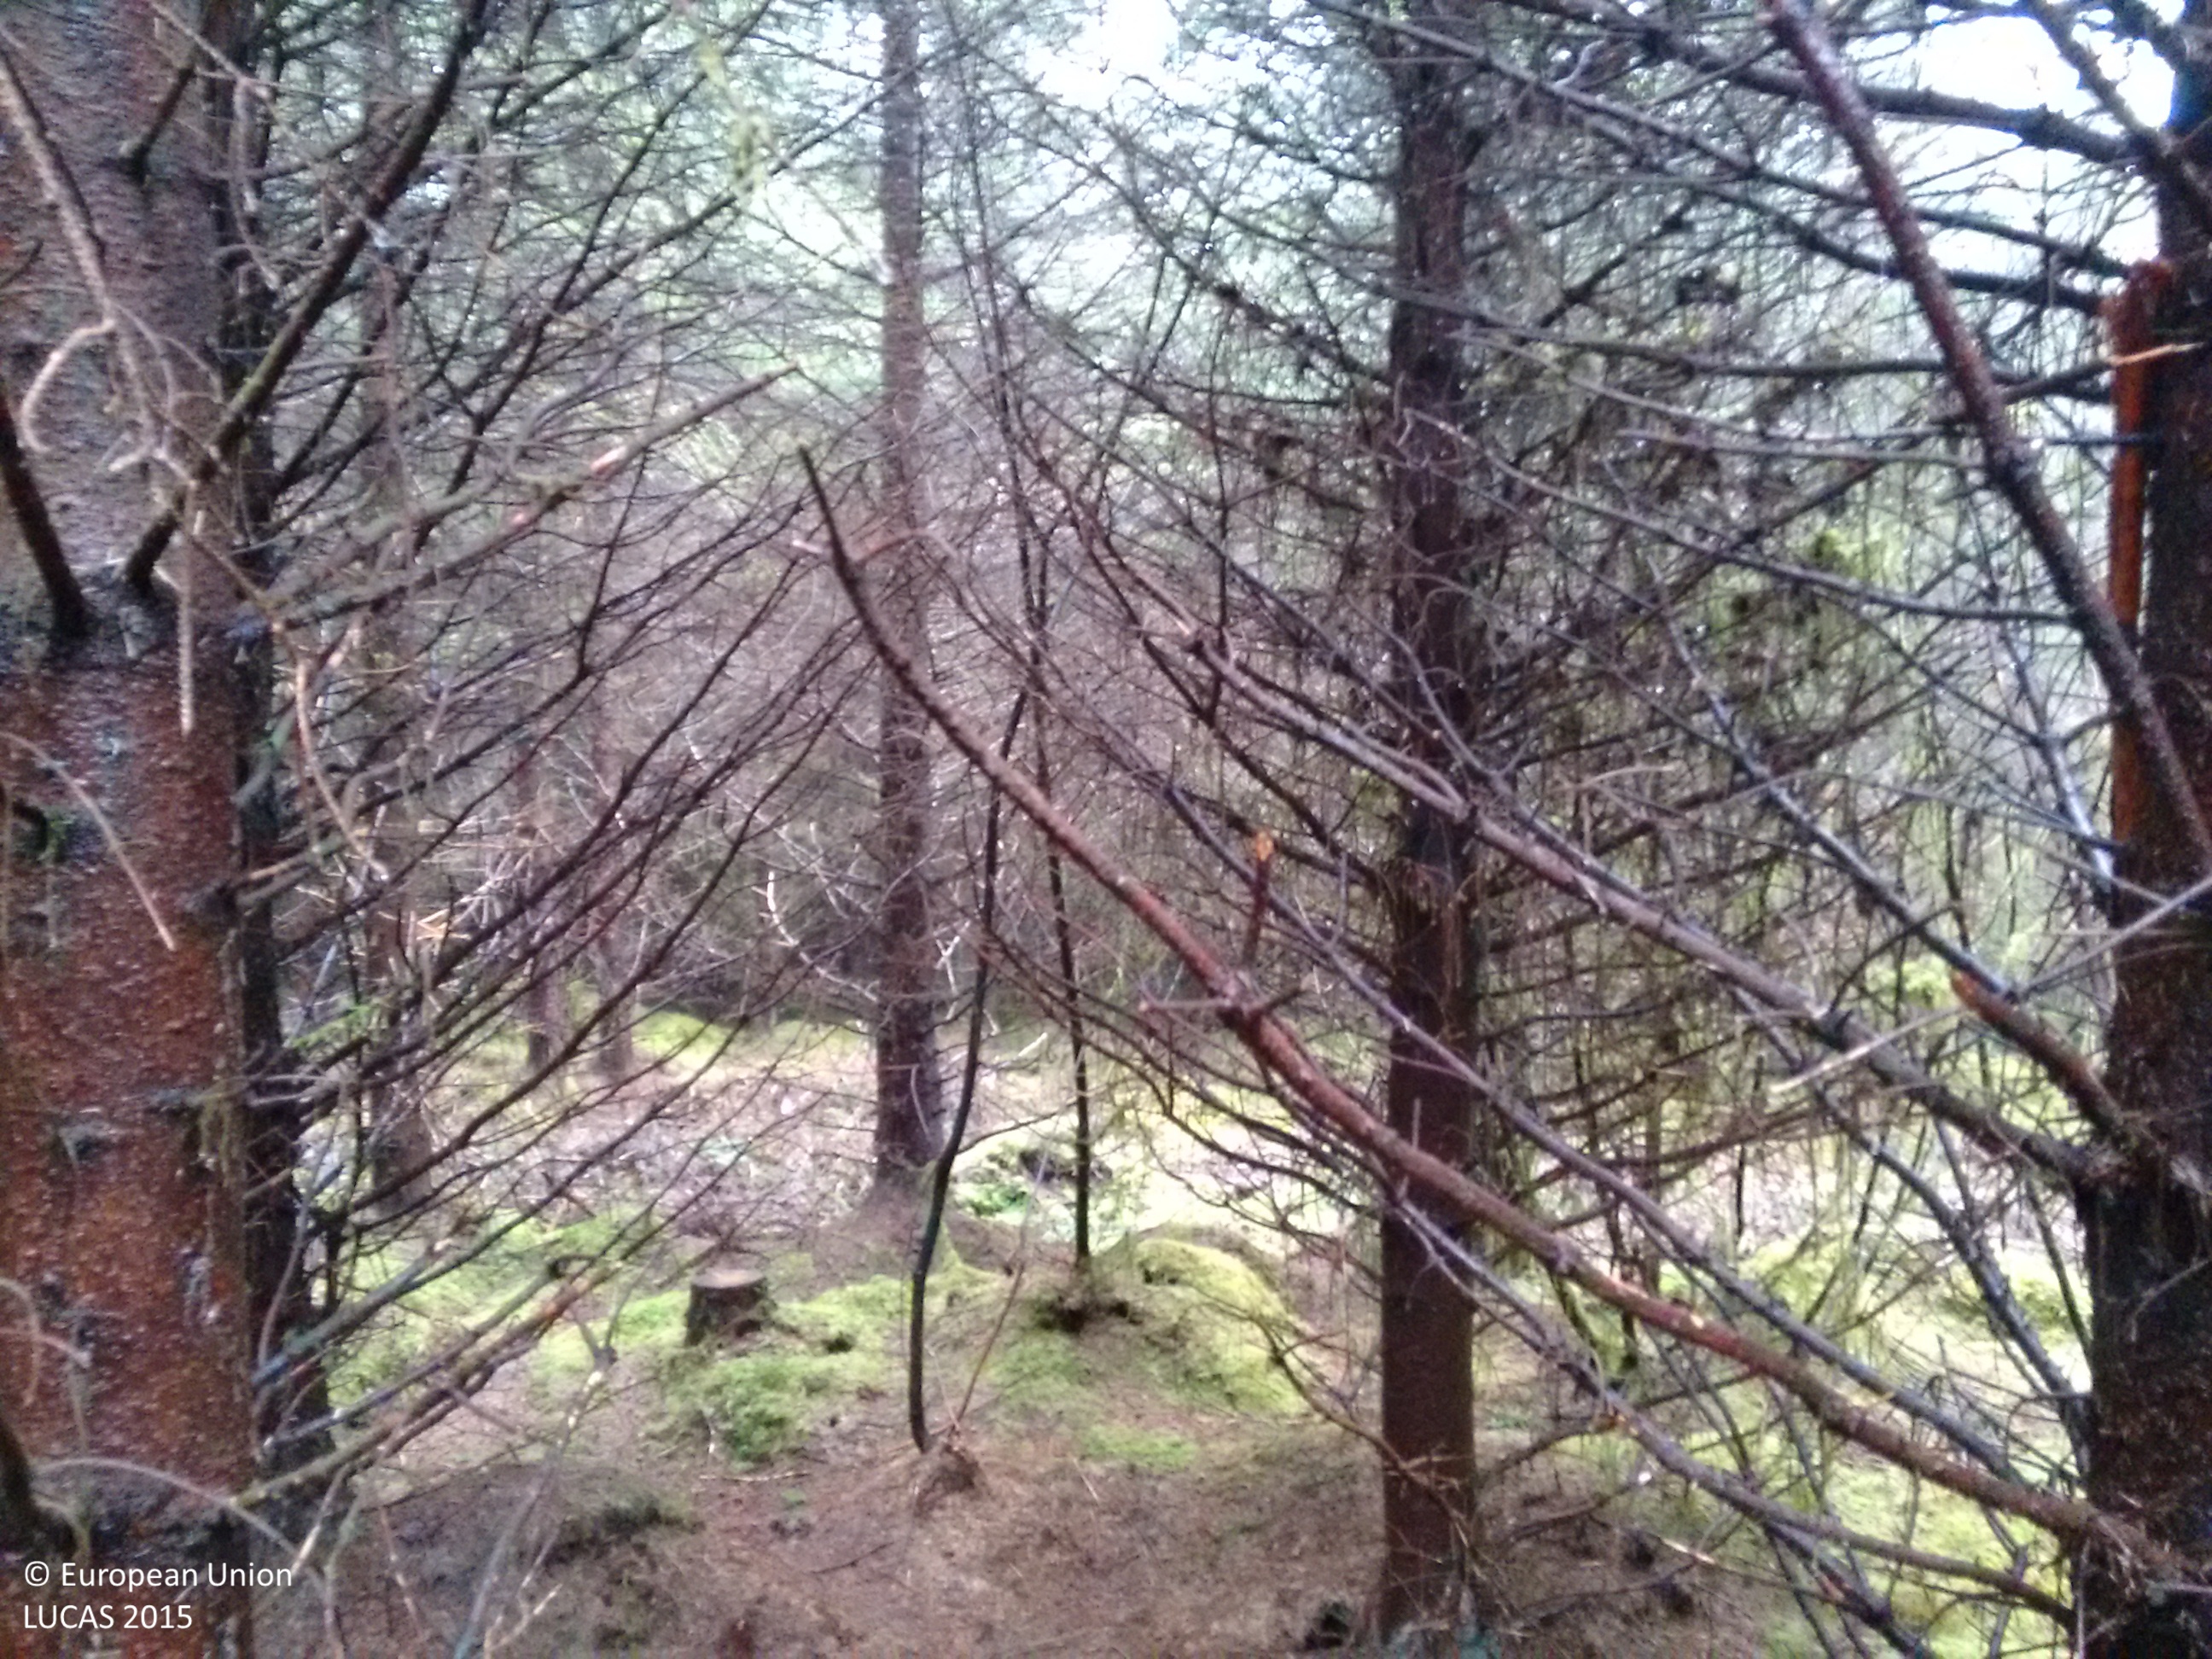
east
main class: Woodland
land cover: Spruce dominated coniferous woodland
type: exotic forest
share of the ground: > 75 %
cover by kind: coniferous forest trees 80 %, lichens and mosses 20 %
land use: Forestry
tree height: > 5 m
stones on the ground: < 10 %
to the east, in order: Spruce dominated coniferous woodland
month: November
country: IE
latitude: 54.3257
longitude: -8.1216
